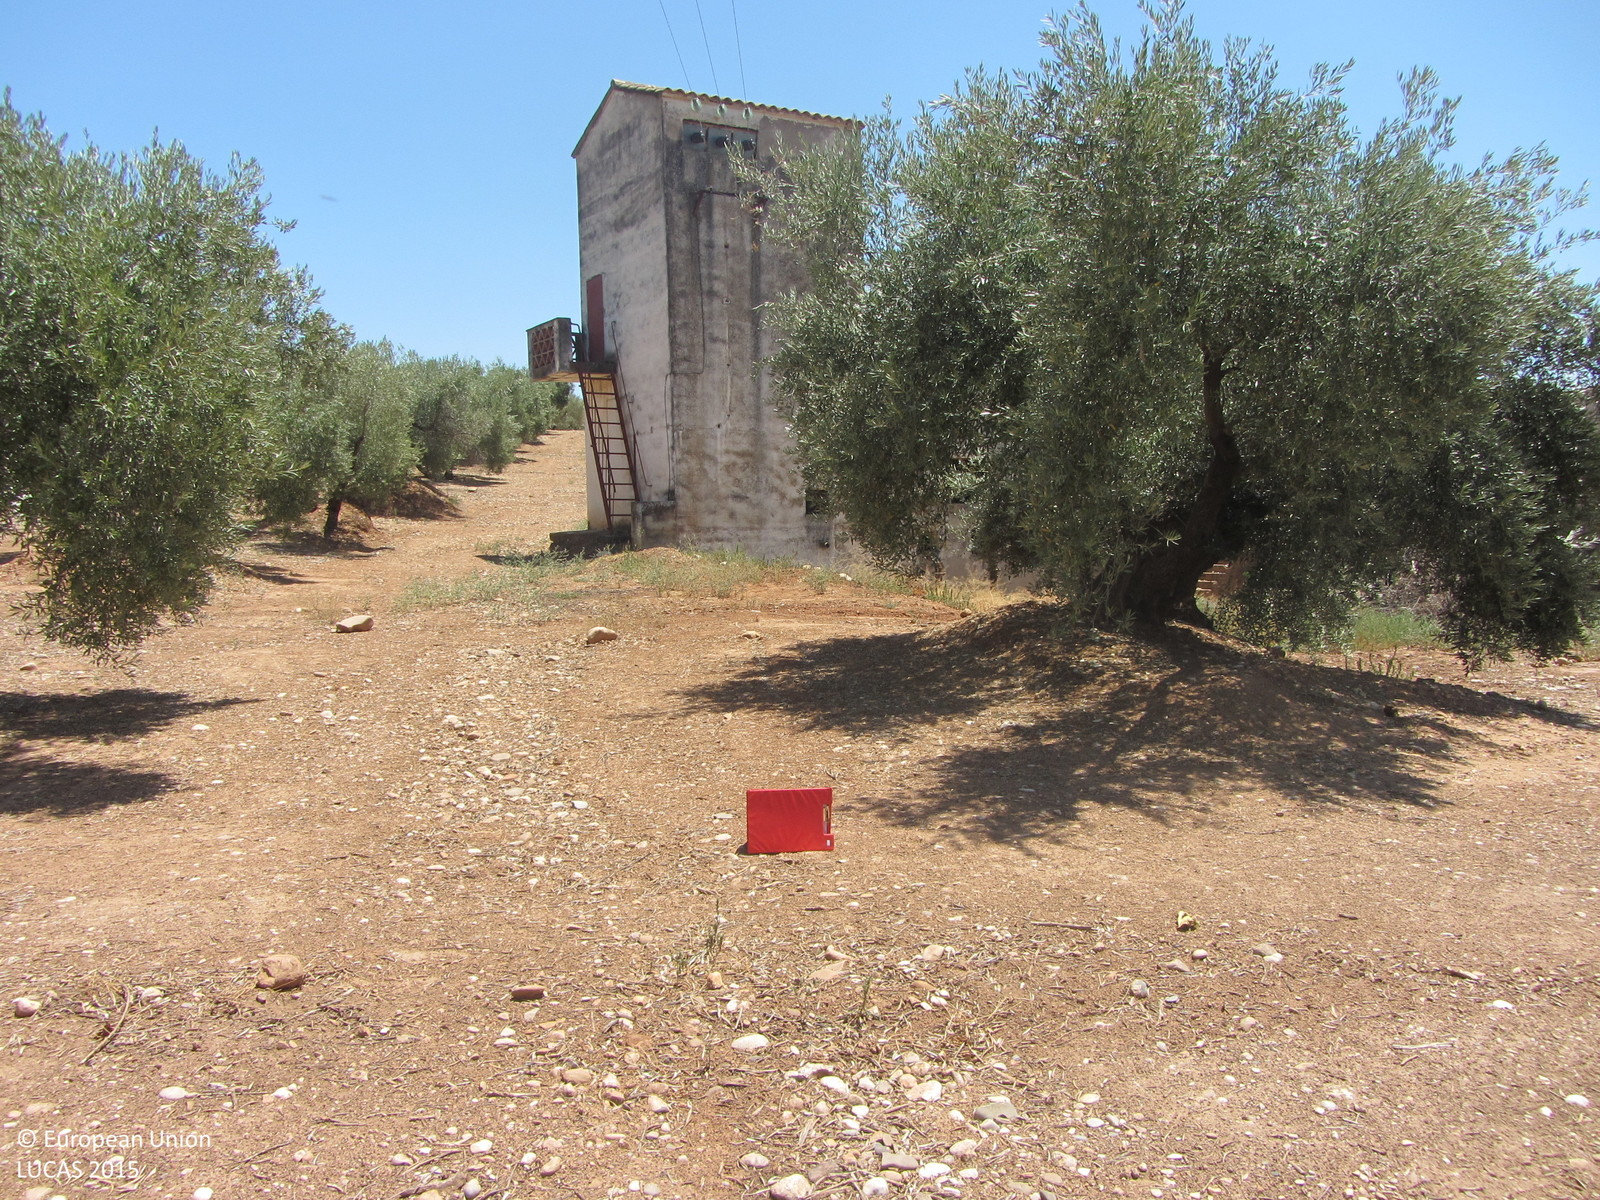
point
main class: Cropland
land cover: Olive groves
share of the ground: 25 - 50 %
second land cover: Other bare soil
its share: > 75 %
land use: Agriculture (excluding fallow land and kitchen gardens)
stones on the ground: 10 - 25 %
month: July
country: ES
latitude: 38.0441
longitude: -3.8963
